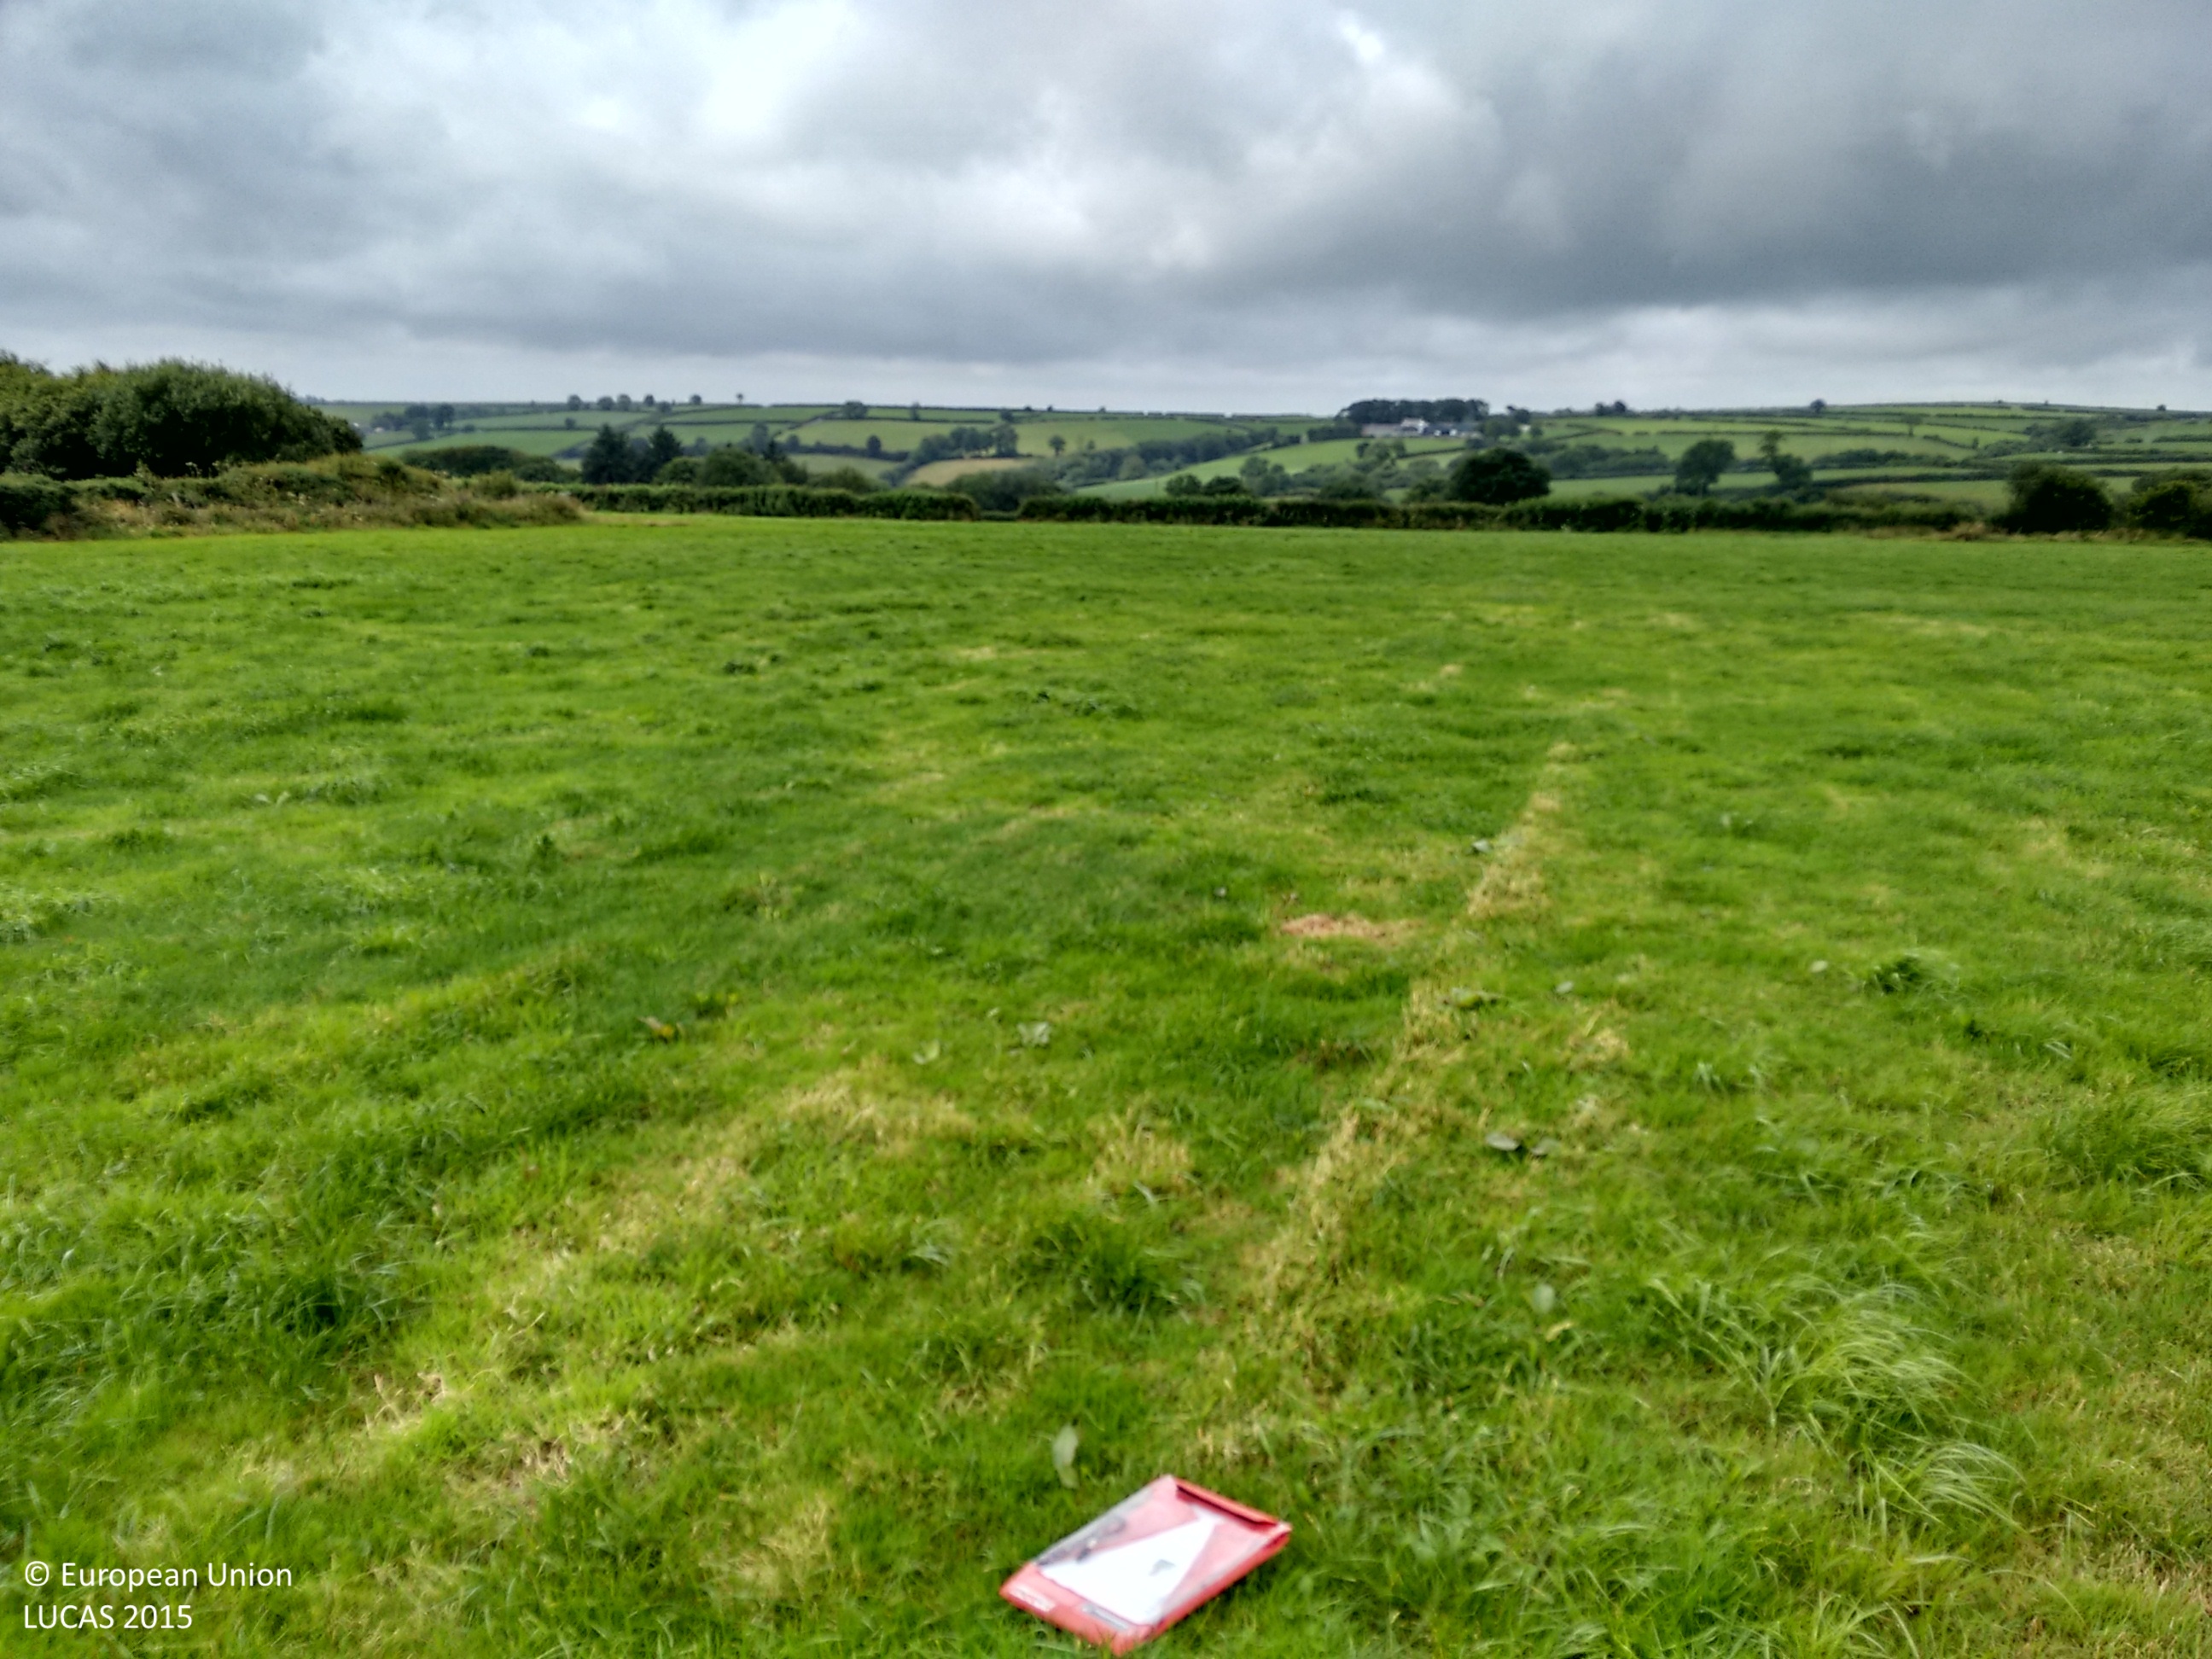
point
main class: Grassland
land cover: Grassland without tree/shrub cover
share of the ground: > 75 %
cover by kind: herbaceous plants 100 %
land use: Agriculture (excluding fallow land and kitchen gardens)
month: August
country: GB
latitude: 51.9459
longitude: -4.4340
